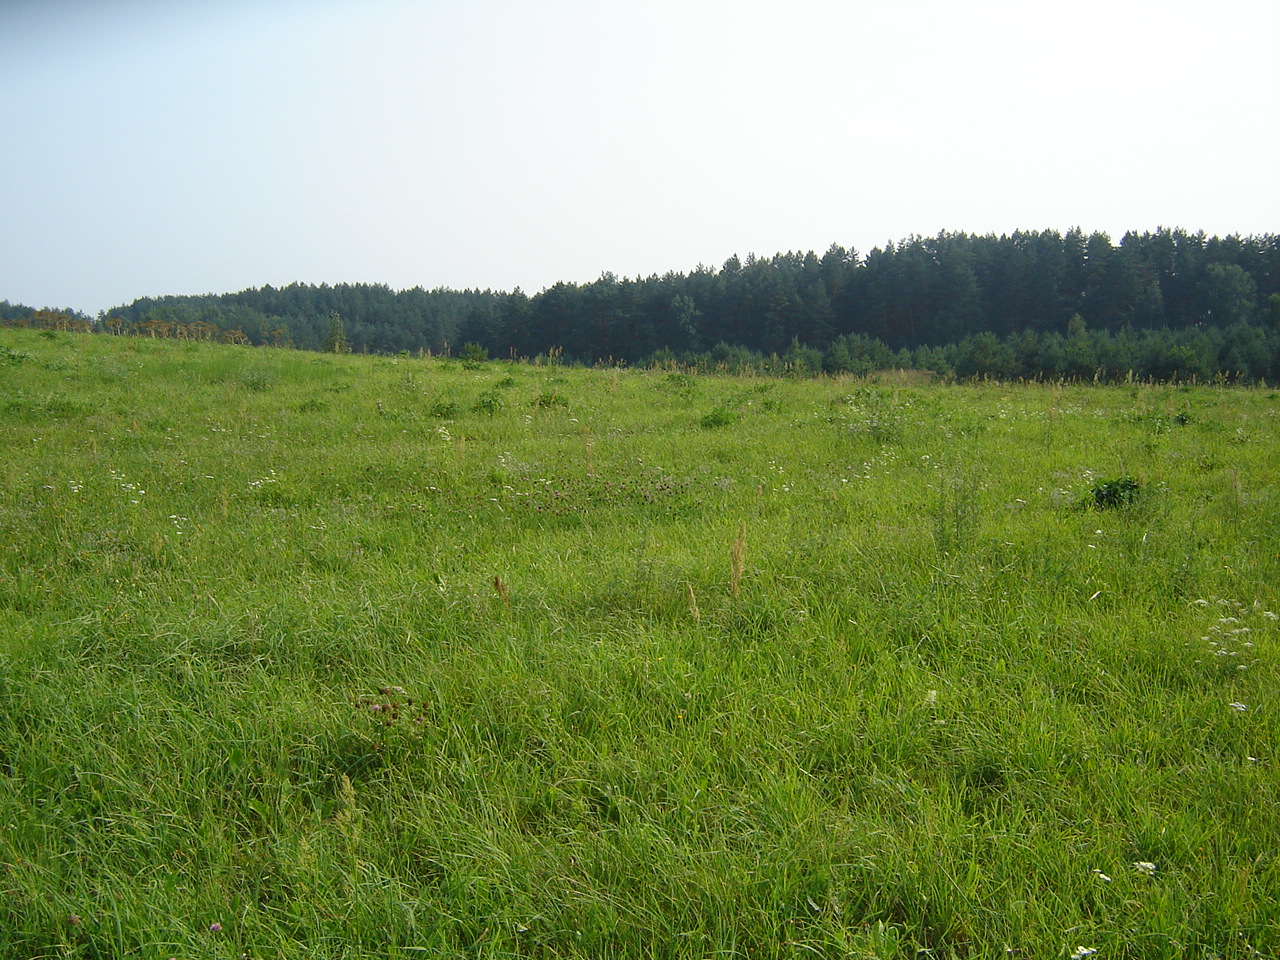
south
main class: Grassland
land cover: Grassland without tree/shrub cover
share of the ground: > 75 %
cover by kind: herbaceous plants 100 %
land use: Agriculture (excluding fallow land and kitchen gardens)
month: August
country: LT
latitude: 54.8960
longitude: 24.8451
